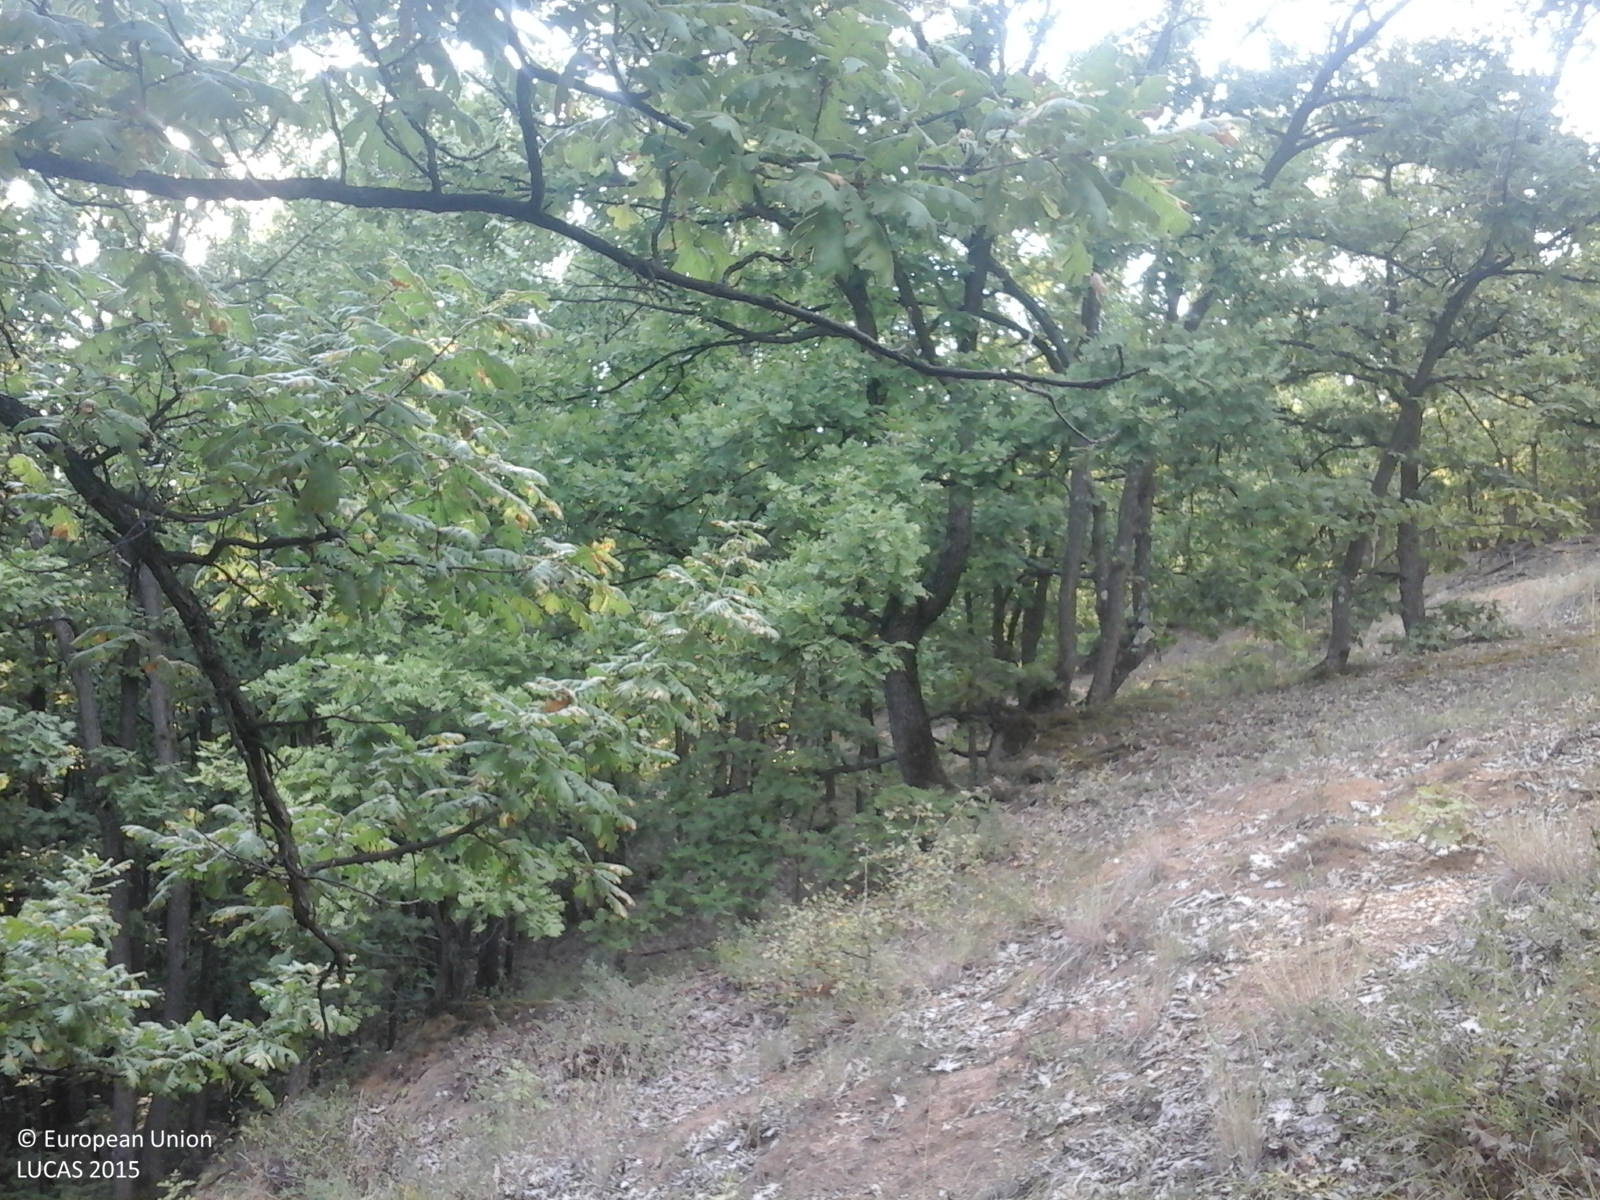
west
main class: Woodland
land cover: Broadleaved woodland
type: acidophilous oak and oak-birch forest
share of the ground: > 75 %
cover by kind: broadleaved forest trees 100 %
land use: Forestry
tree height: > 5 m
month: August
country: RO
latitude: 44.6511
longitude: 23.6374
